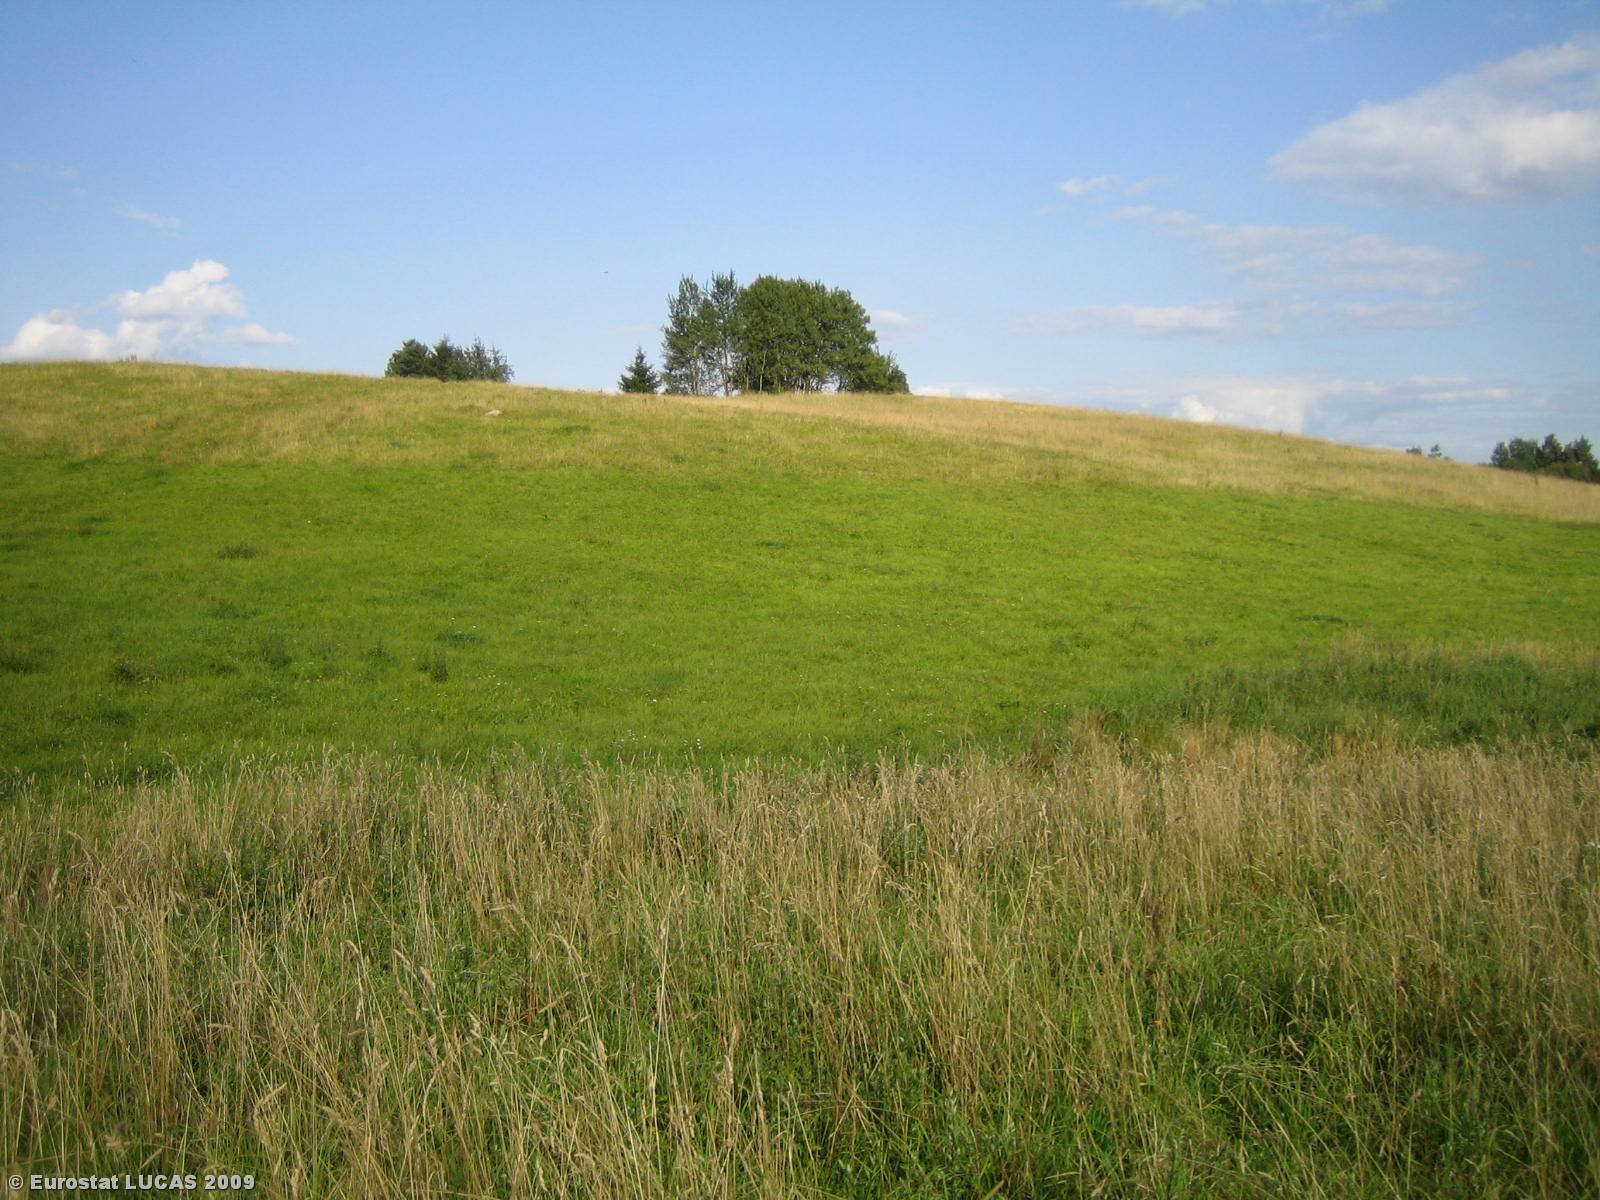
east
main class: Grassland
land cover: Grassland without tree/shrub cover
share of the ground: > 75 %
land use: Agriculture (excluding fallow land and kitchen gardens)
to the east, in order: Grassland without tree/shrub cover; Single bushes/trees; Grassland without tree/shrub cover
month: August
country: LT
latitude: 54.7146
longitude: 24.5238
